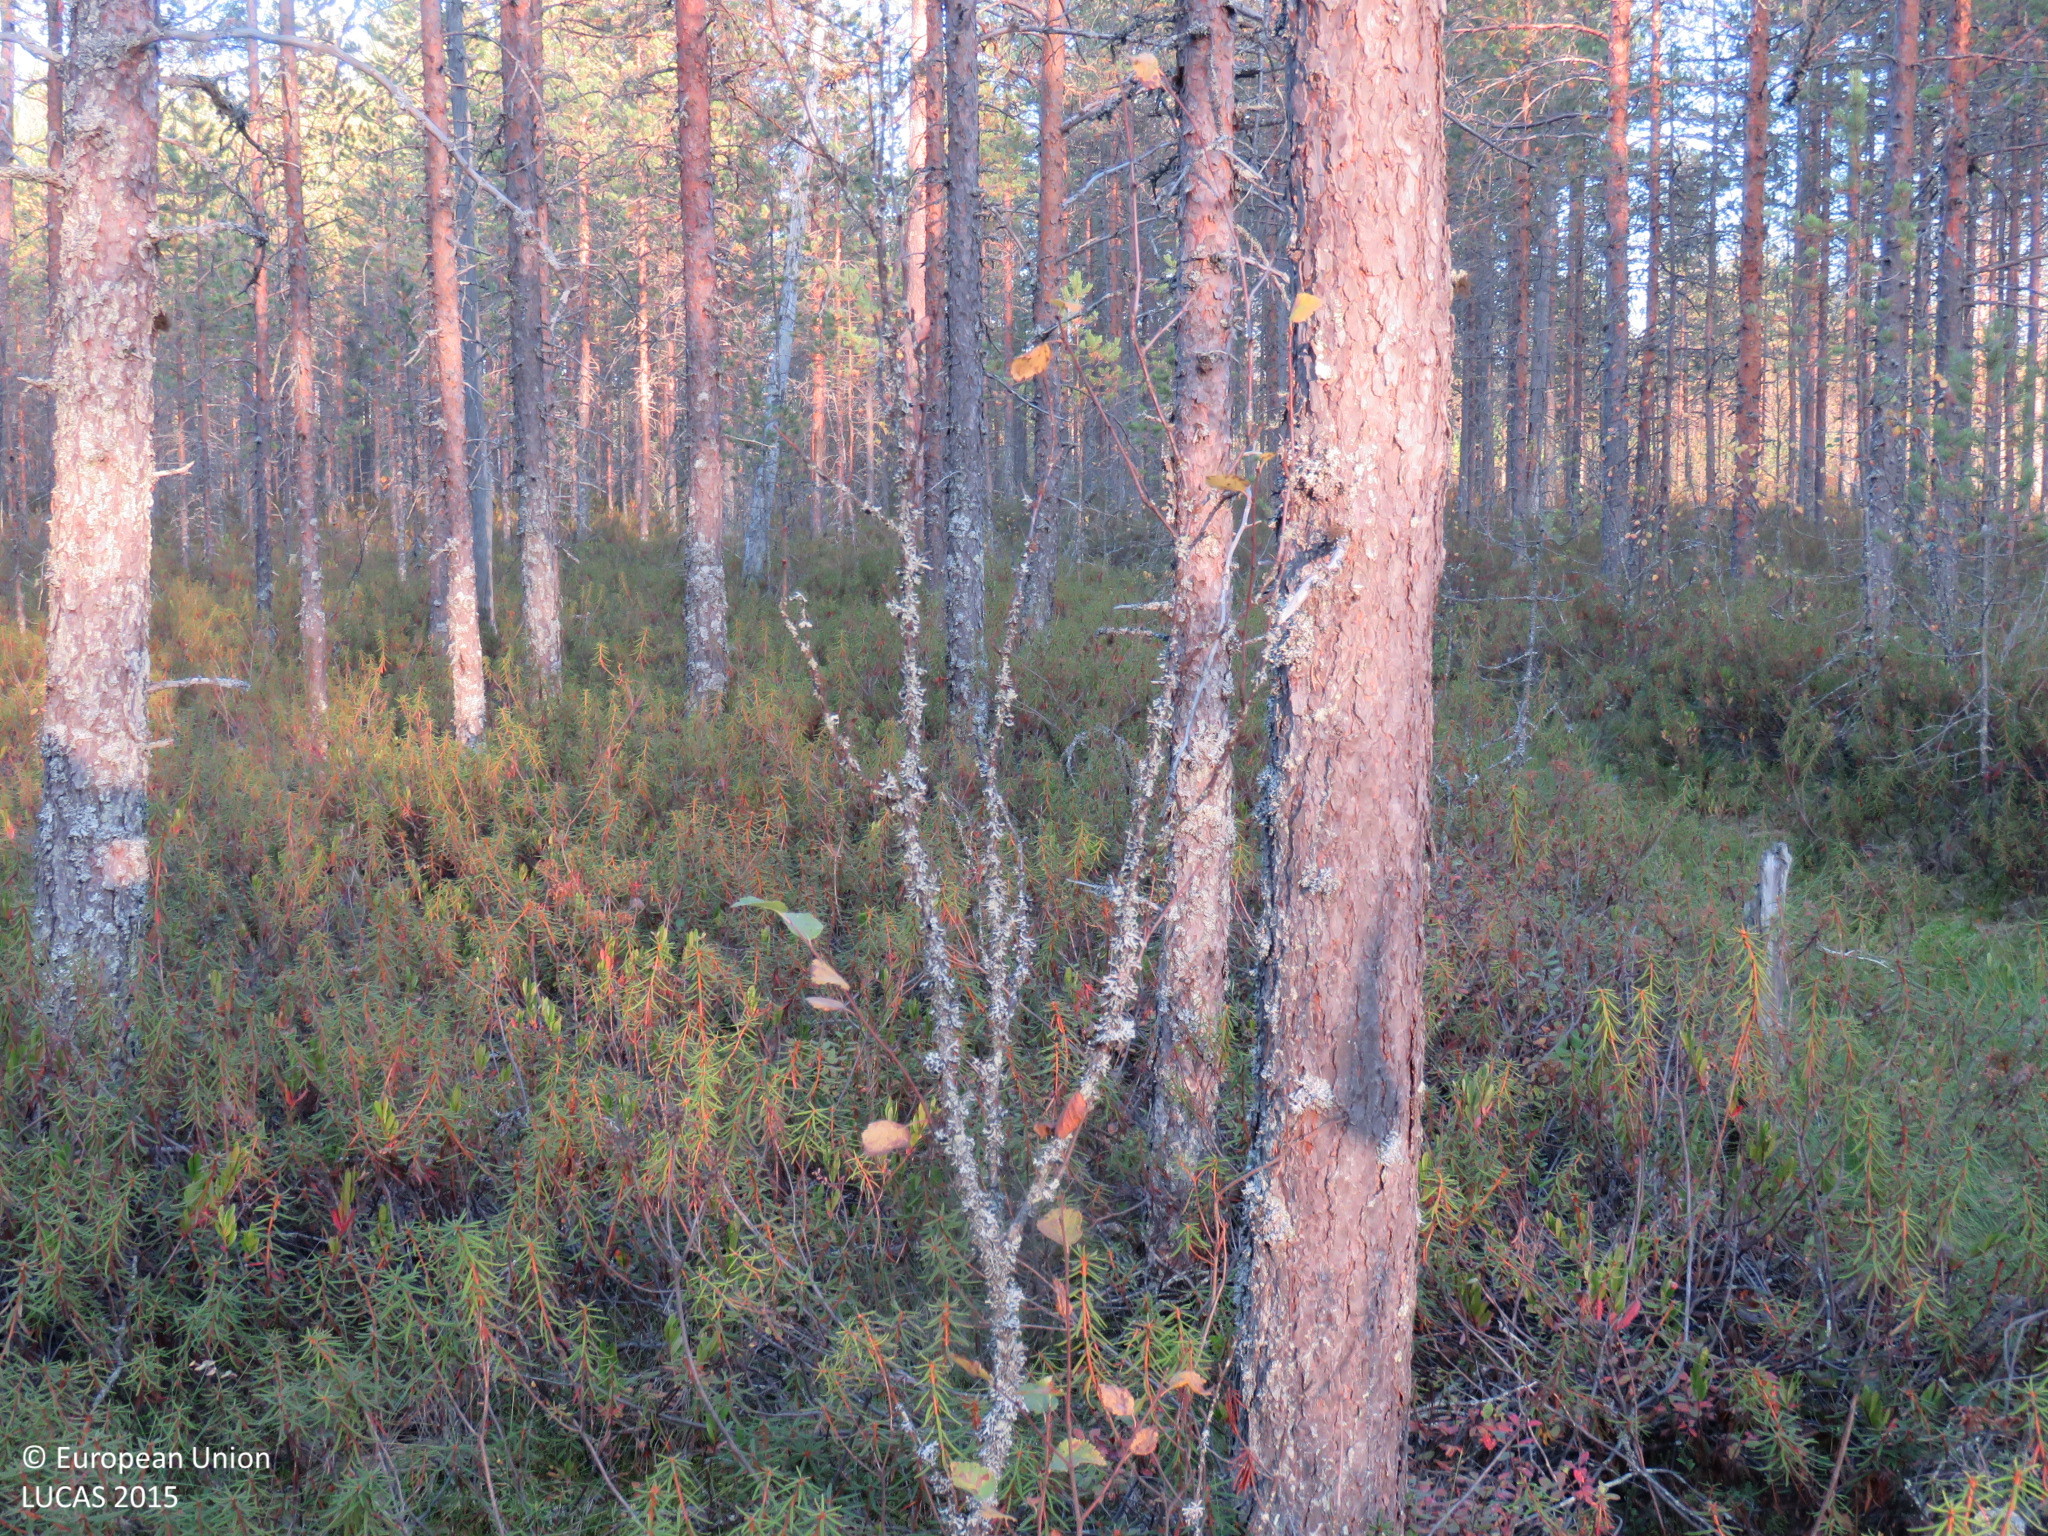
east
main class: Woodland
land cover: Pine dominated coniferous woodland
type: mire and swamp forests
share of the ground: > 75 %
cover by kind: coniferous forest trees 70 %, shrubs 15 %, broadleaved forest trees 5 %, herbaceous plants 5 %, lichens and mosses 5 %
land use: Forestry
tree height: > 5 m
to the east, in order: Pine dominated coniferous woodland; Ditches and canals; Pine dominated coniferous woodland; Ditches and canals; Pine dominated coniferous woodland; Pine dominated mixed woodland
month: September
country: FI
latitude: 65.0354
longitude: 26.7845
